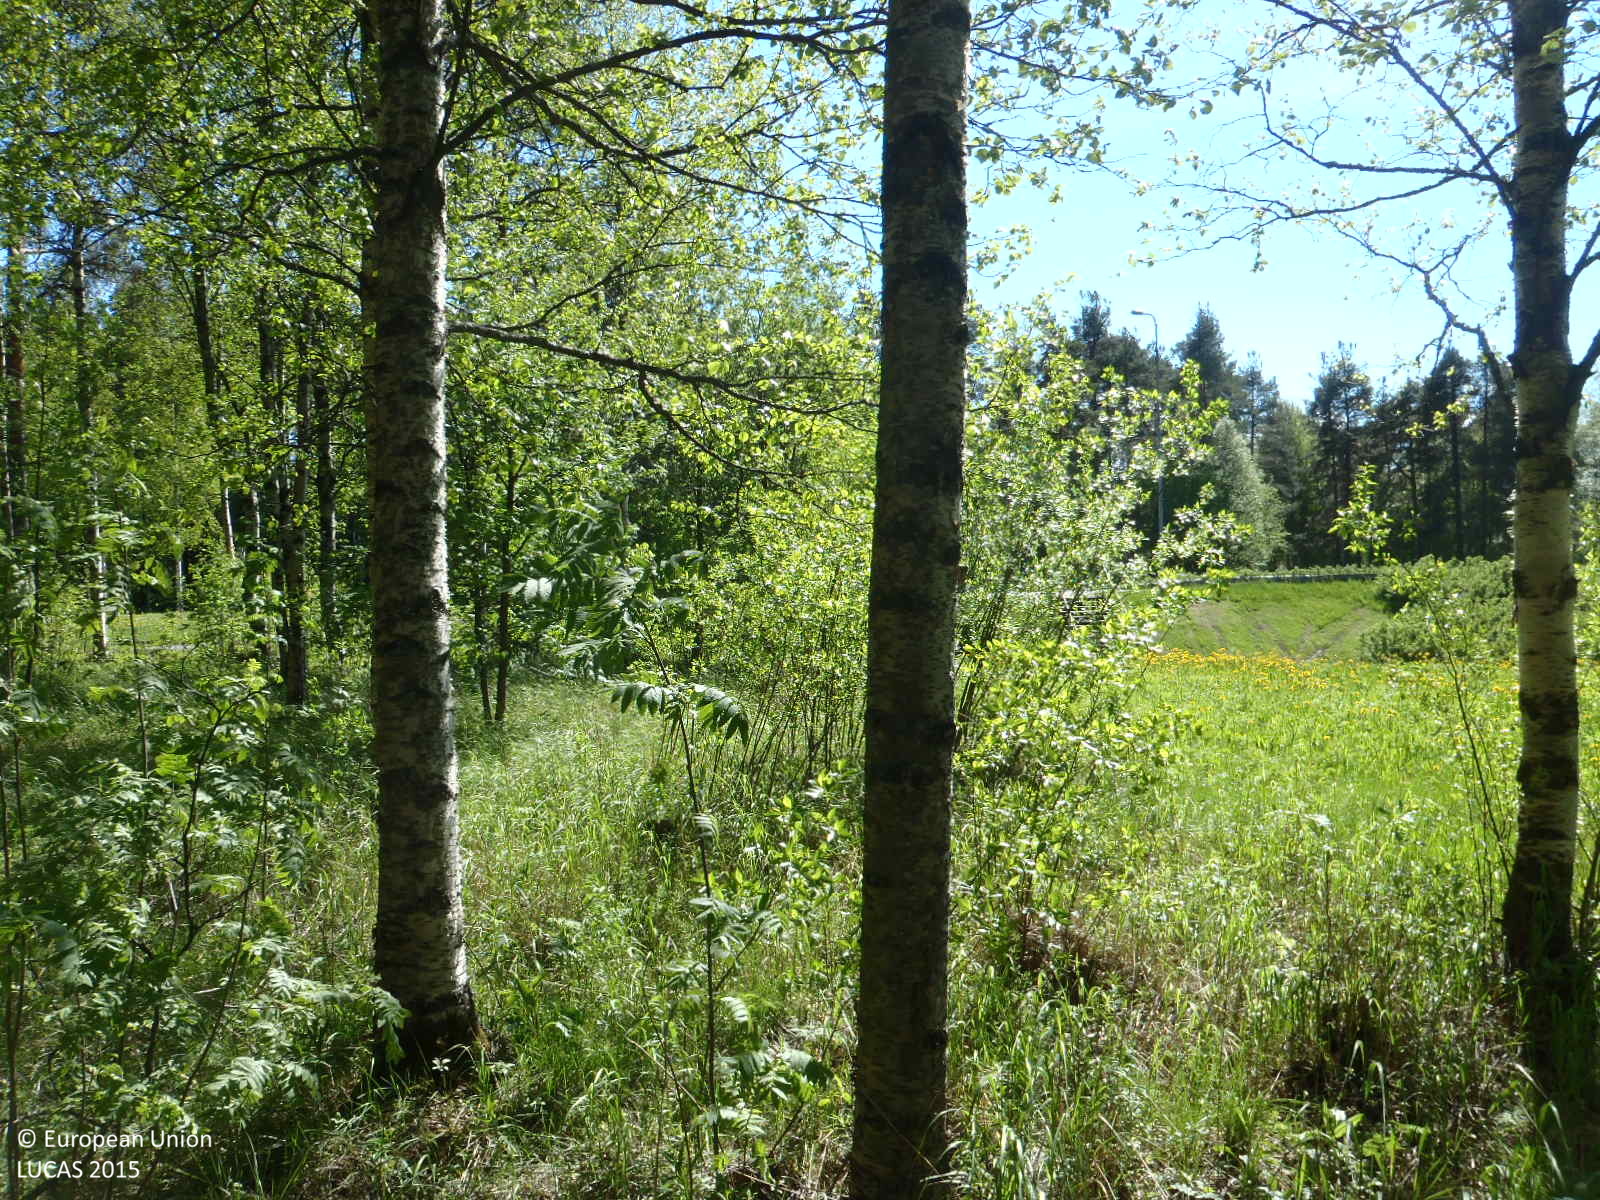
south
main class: Woodland
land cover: Other mixed woodland
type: boreal forest
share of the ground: 50 - 75 %
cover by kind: broadleaved forest trees 40 %, herbaceous plants 30 %, coniferous forest trees 20 %, shrubs 10 %
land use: Amenities, museums, leisure
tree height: > 5 m
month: June
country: FI
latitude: 64.9983
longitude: 25.5001
